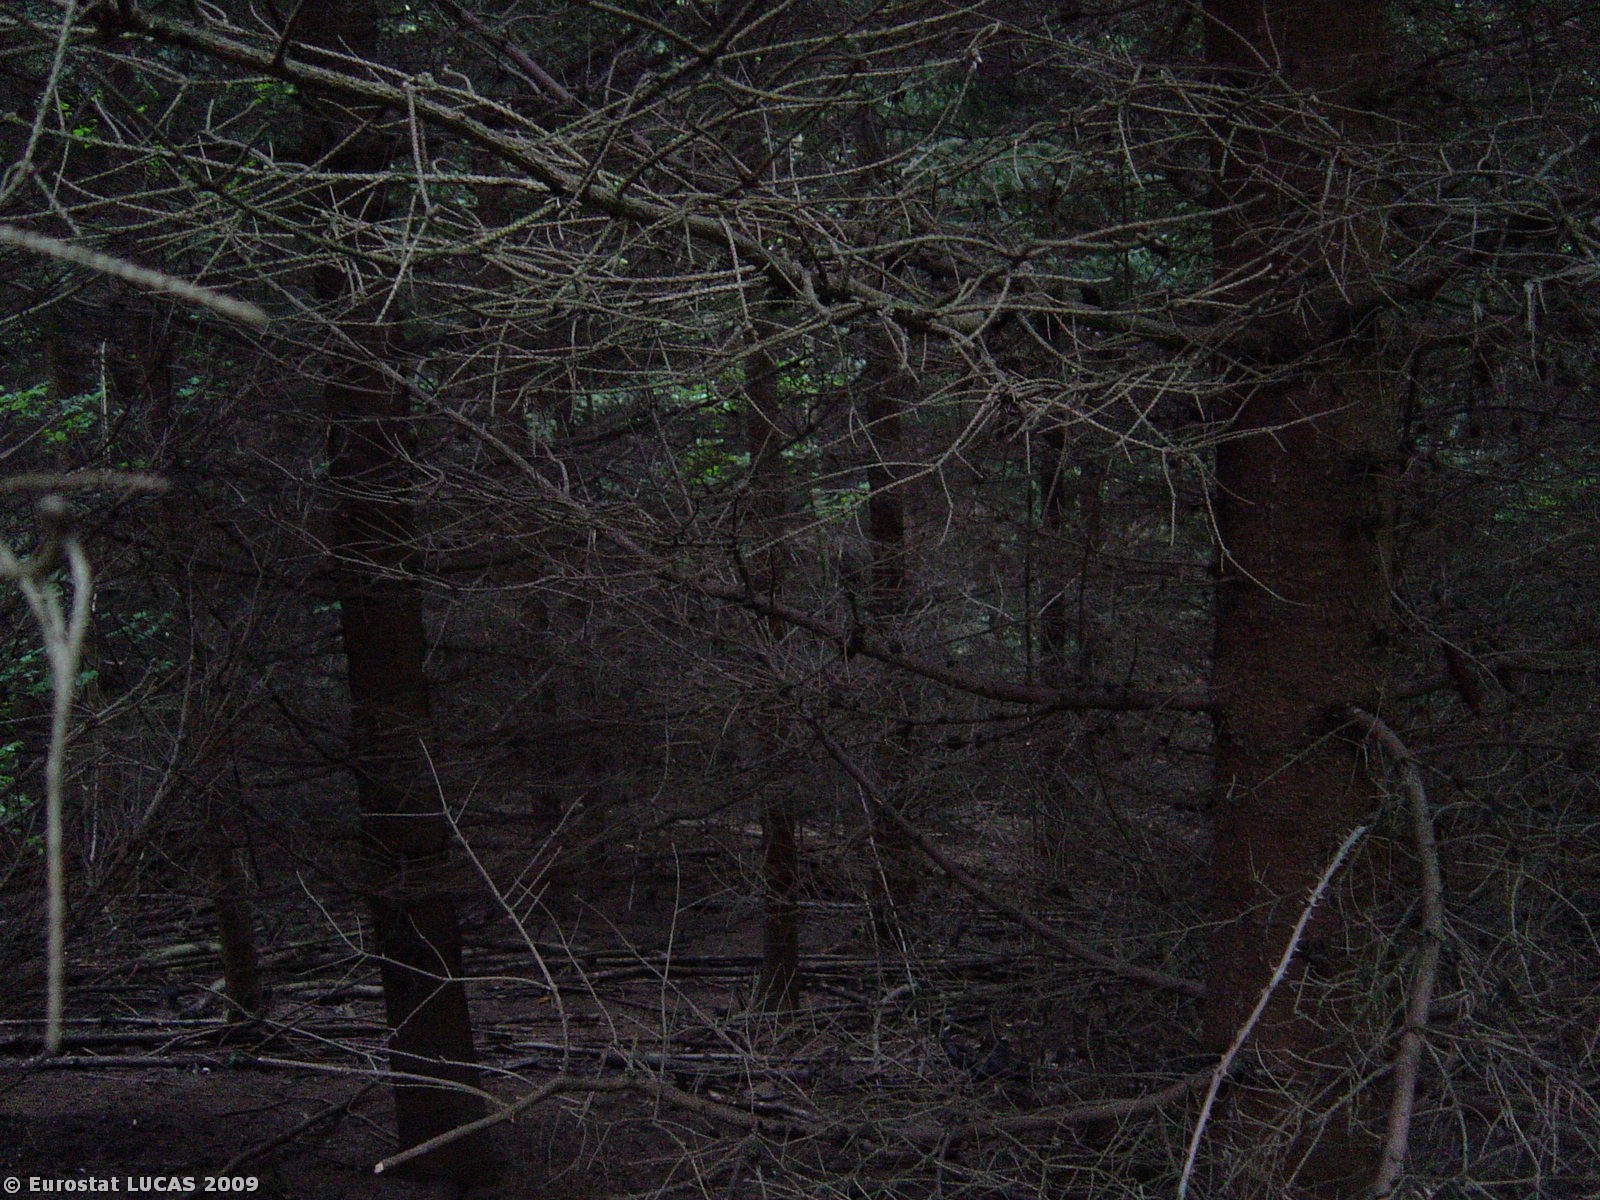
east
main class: Woodland
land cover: Coniferous woodland
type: hemiboreal forest and nemoral coniferous forest and mixed broadleaved-coniferous forest
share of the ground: > 75 %
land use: Forestry
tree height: > 5 m
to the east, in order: Coniferous woodland; Broadleaved woodland; Mixed woodland; Coniferous woodland; Tracks; Broadleaved woodland
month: June
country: CZ
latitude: 49.2024
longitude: 17.1329
